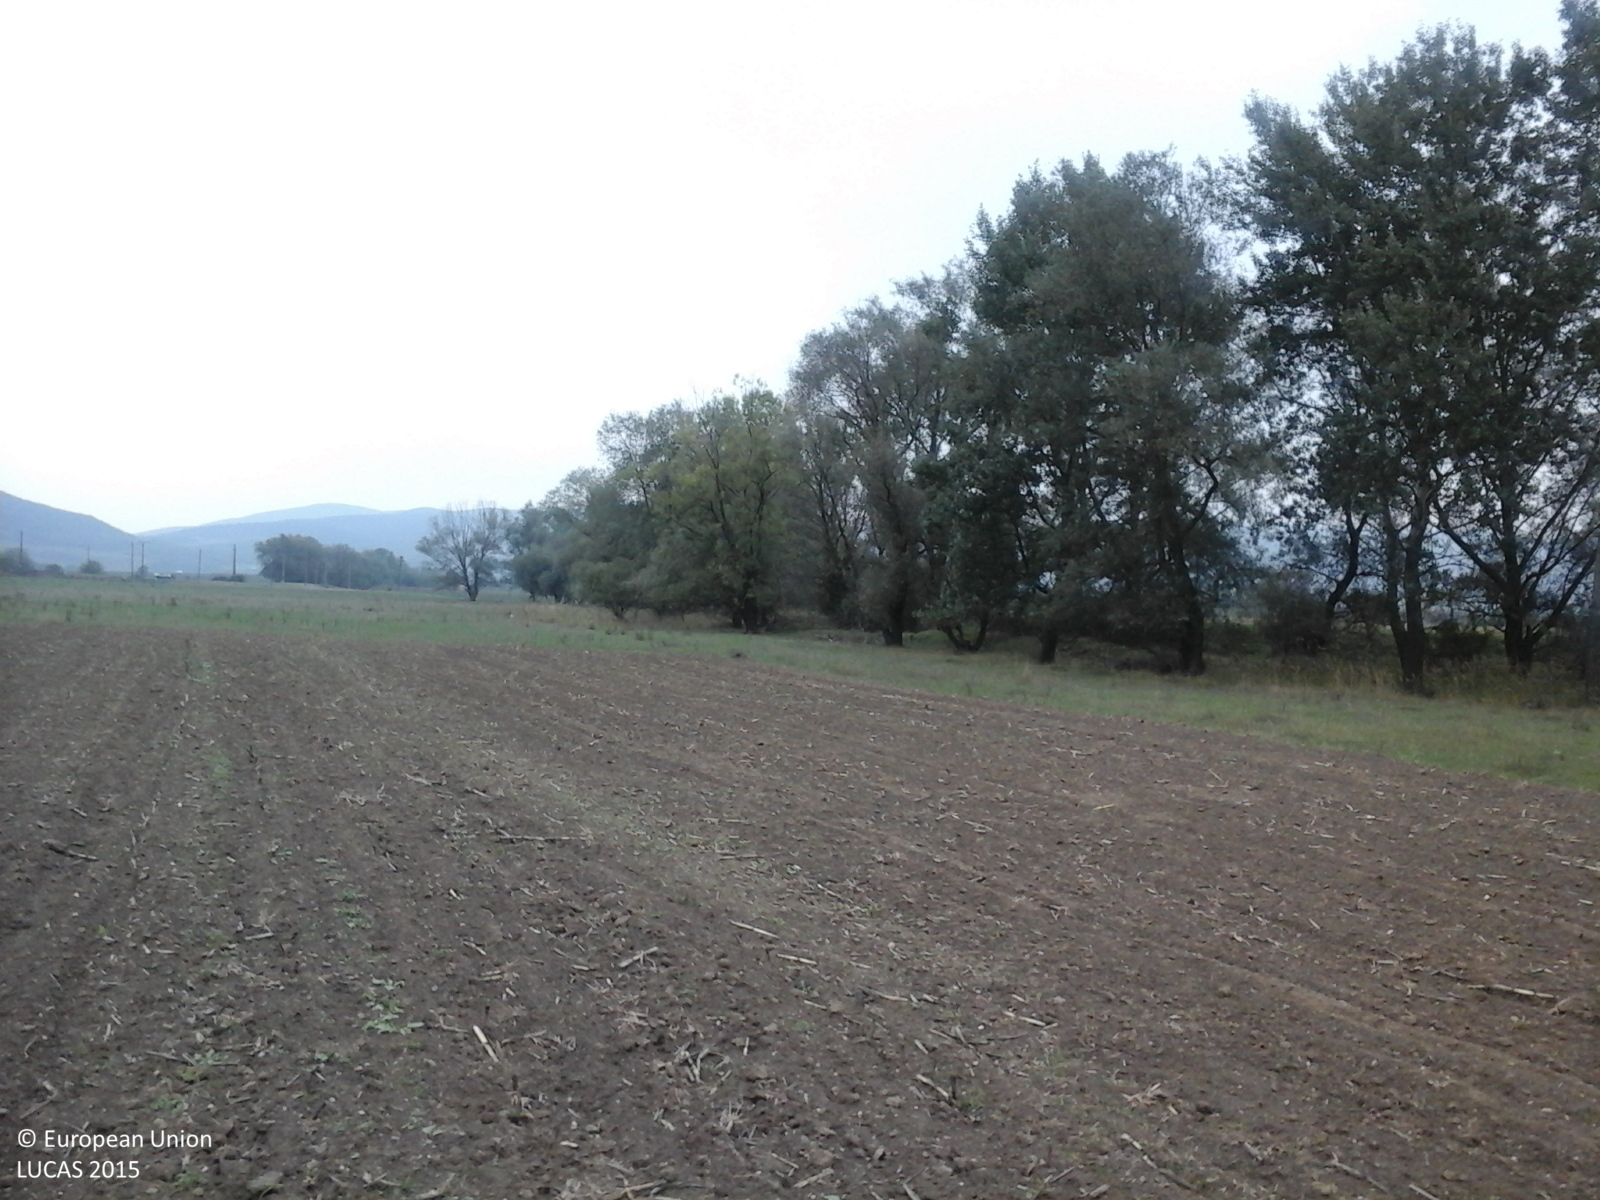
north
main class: Cropland
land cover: Maize
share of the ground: < 10 %
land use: Agriculture (excluding fallow land and kitchen gardens)
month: September
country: RO
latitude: 45.8367
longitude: 23.0725
